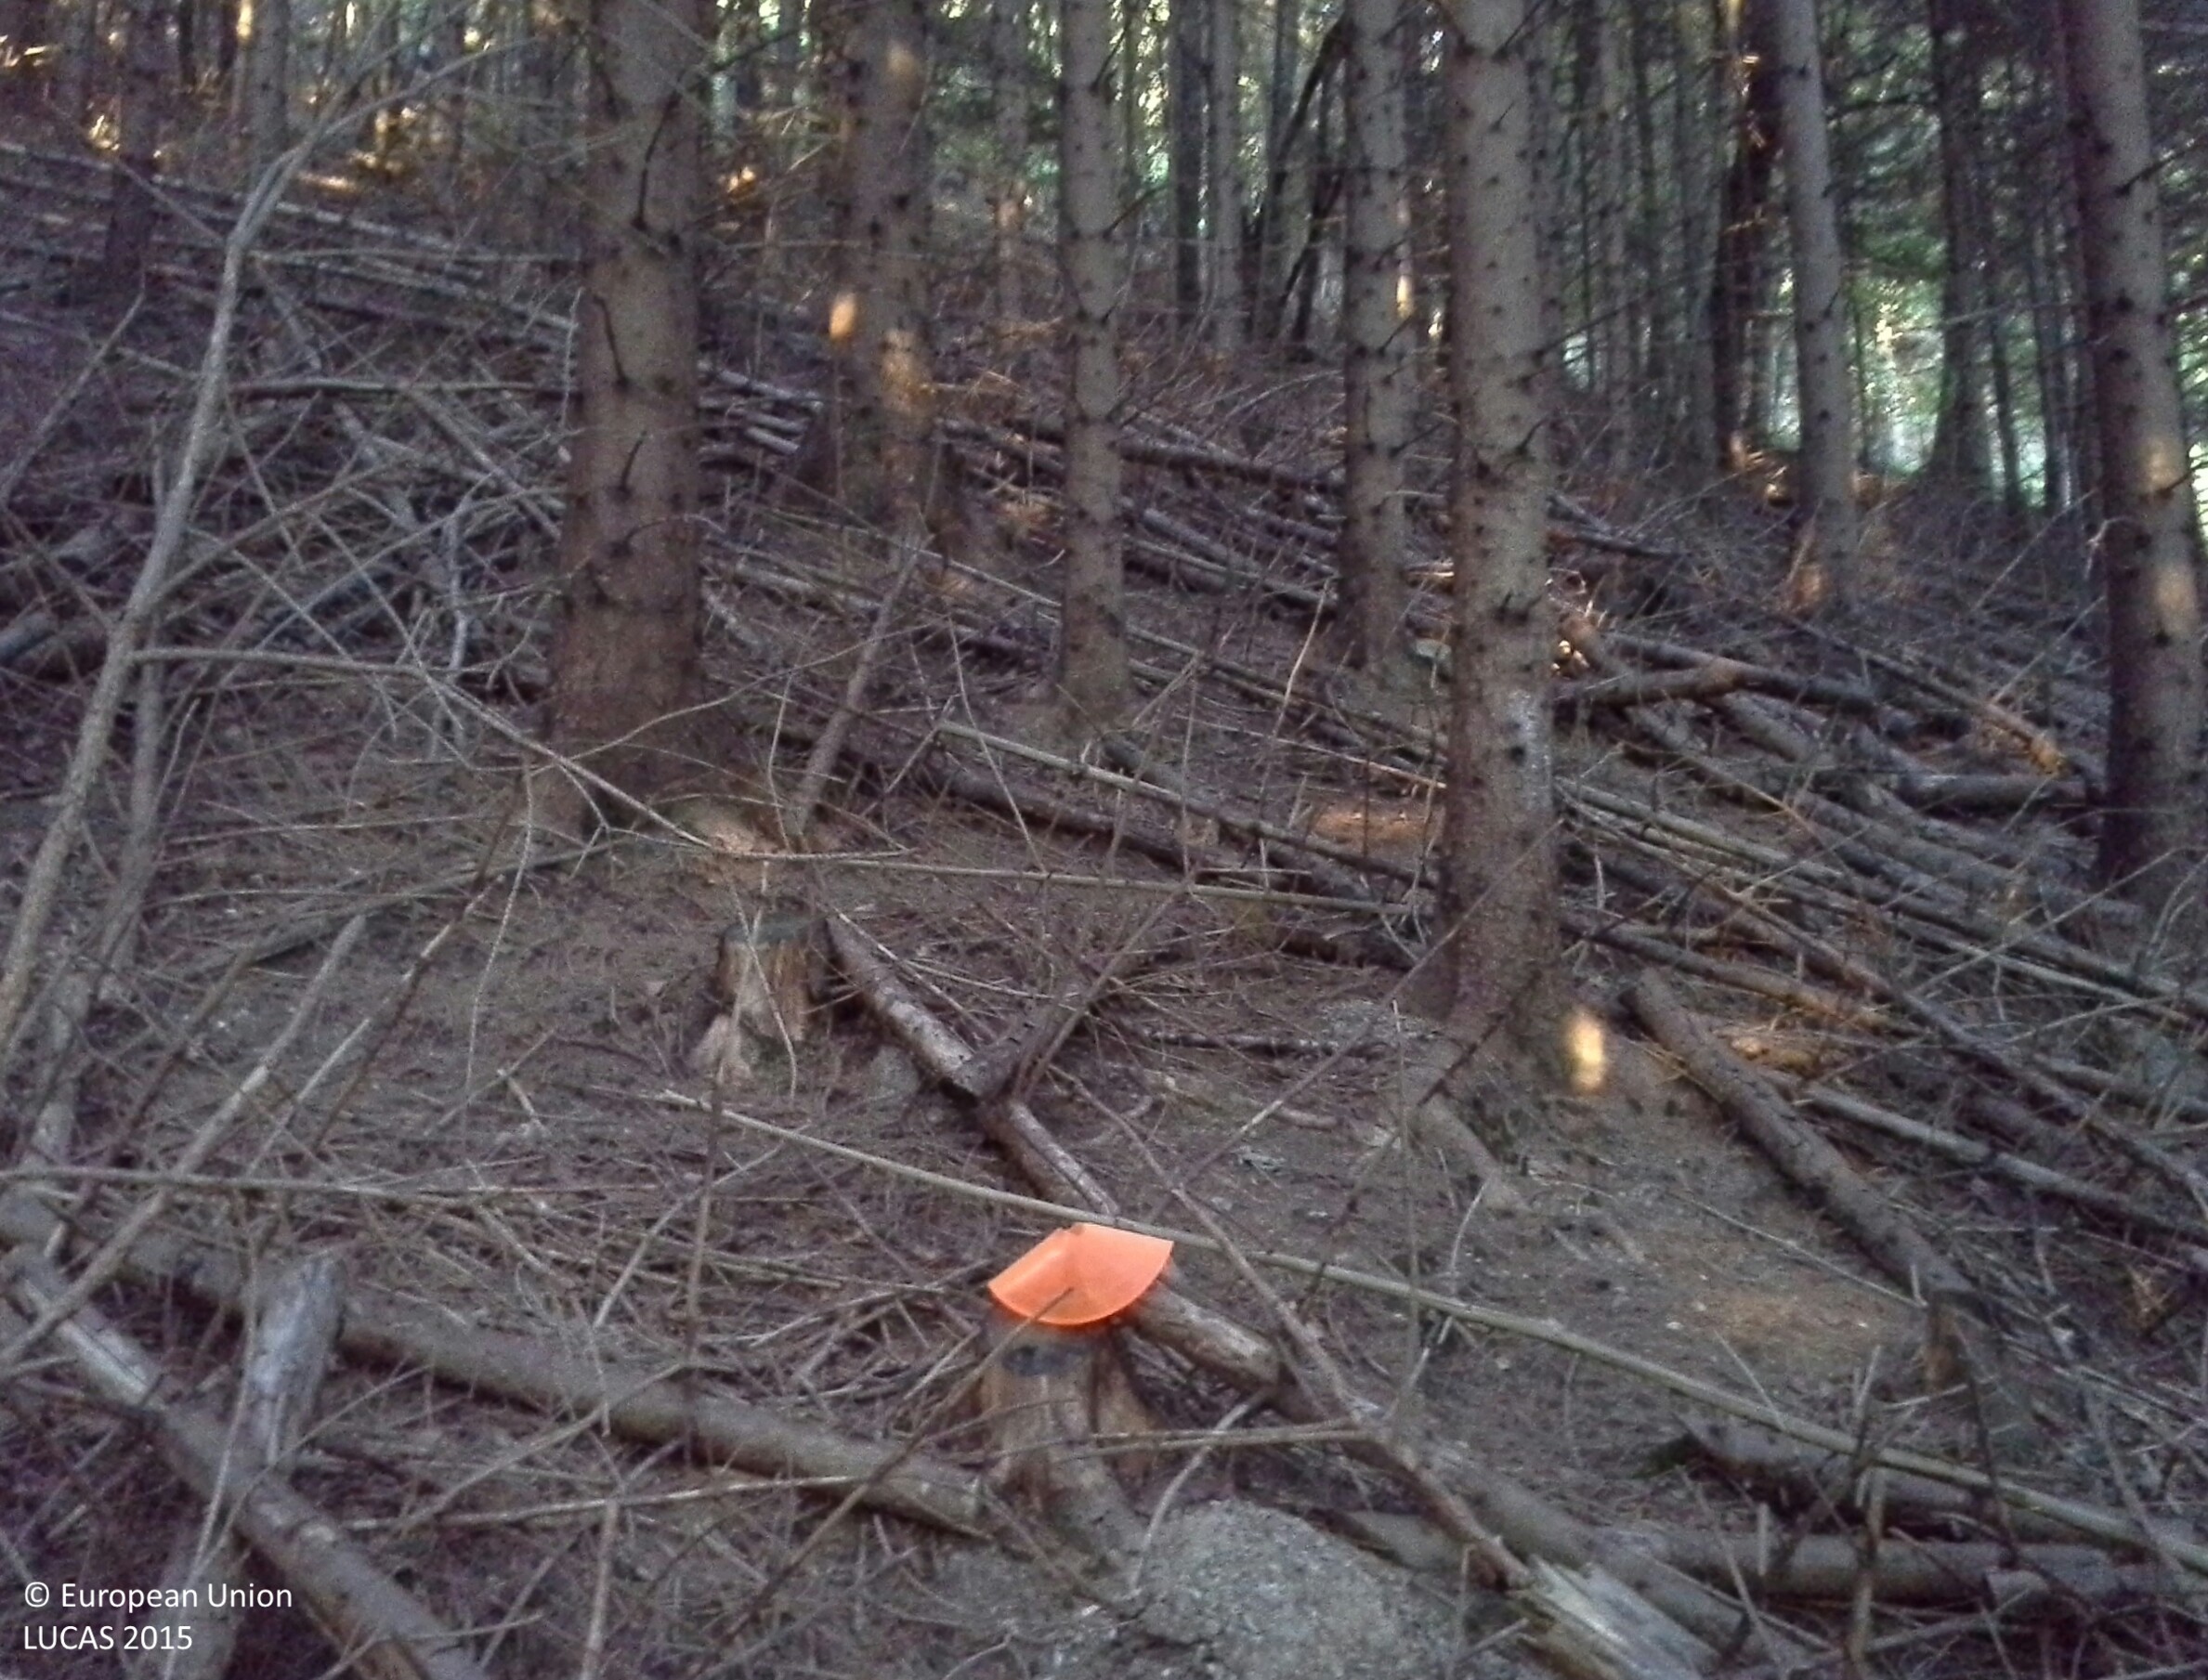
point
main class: Woodland
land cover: Spruce dominated coniferous woodland
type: alpine coniferous forest
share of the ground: > 75 %
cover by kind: coniferous forest trees 100 %
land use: Forestry
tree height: > 5 m
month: July
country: AT
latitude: 47.9308
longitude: 14.5642
